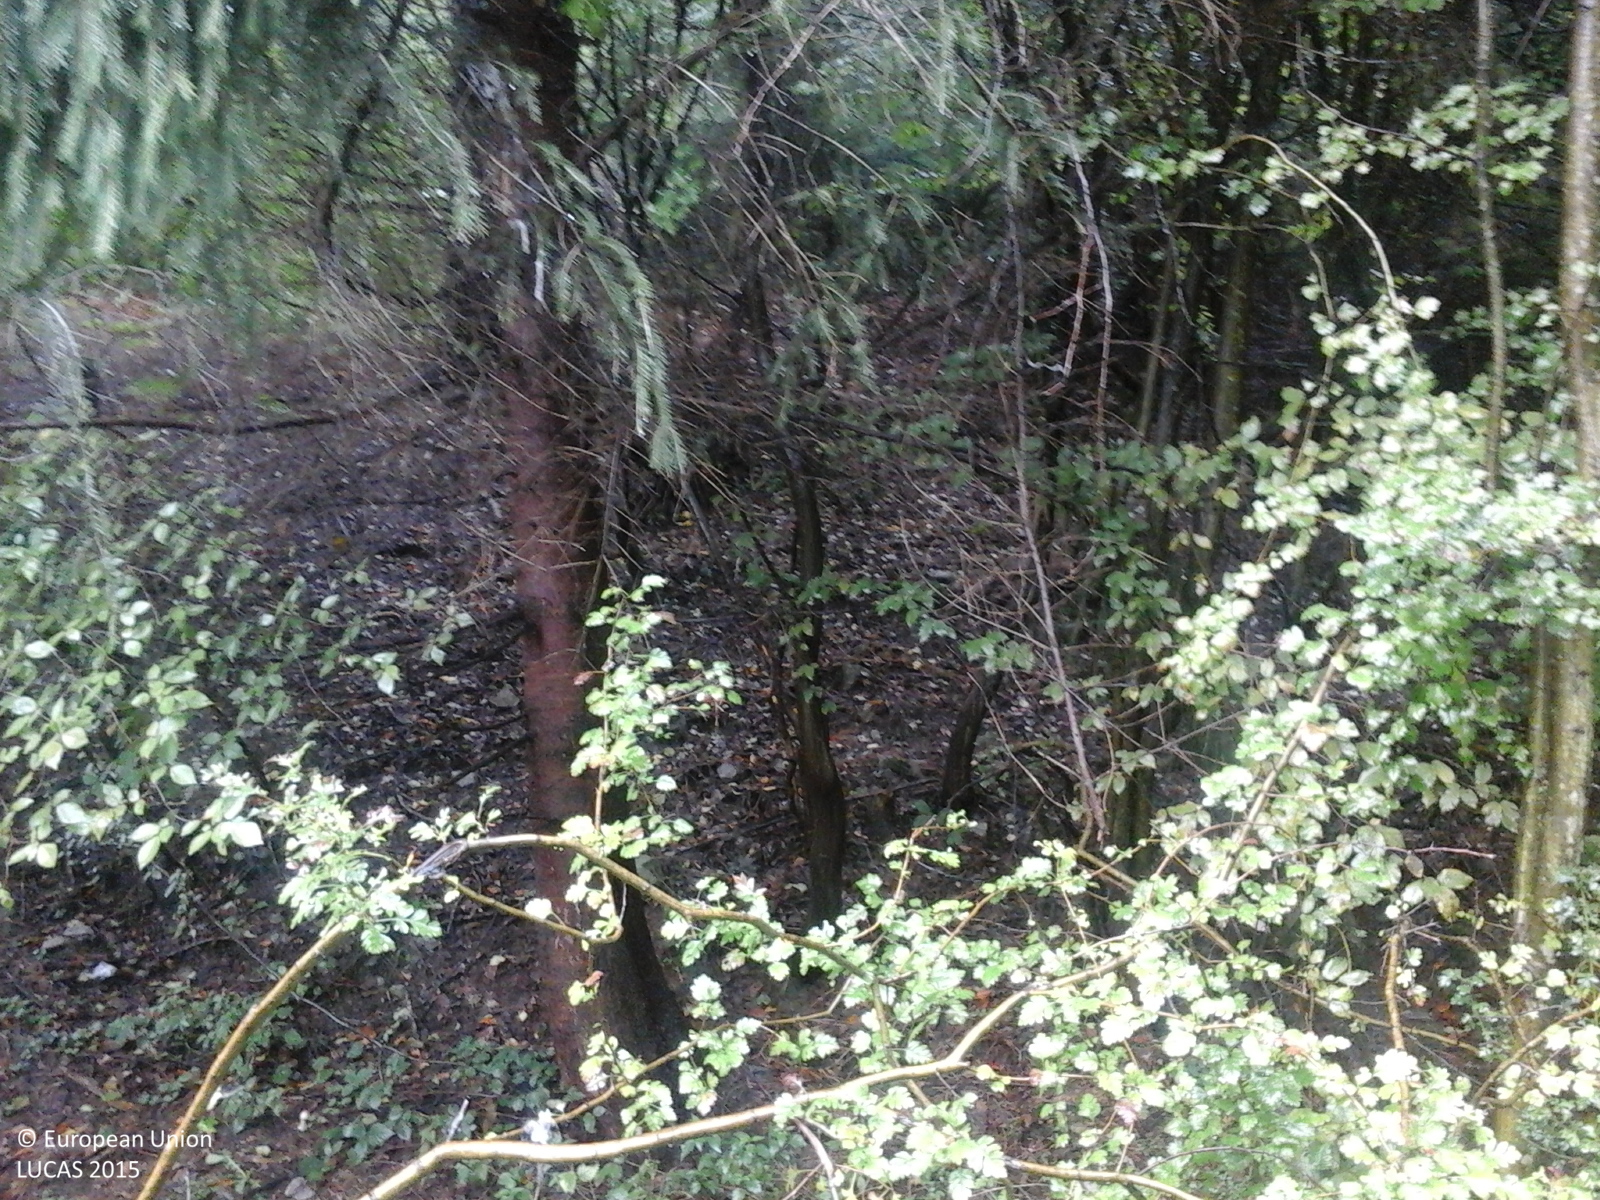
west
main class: Artificial land
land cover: Non built-up area features
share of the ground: > 75 %
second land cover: Spontaneously vegetated surfaces
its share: > 75 %
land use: Abandoned areas
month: September
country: RO
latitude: 45.2026
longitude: 23.7487
